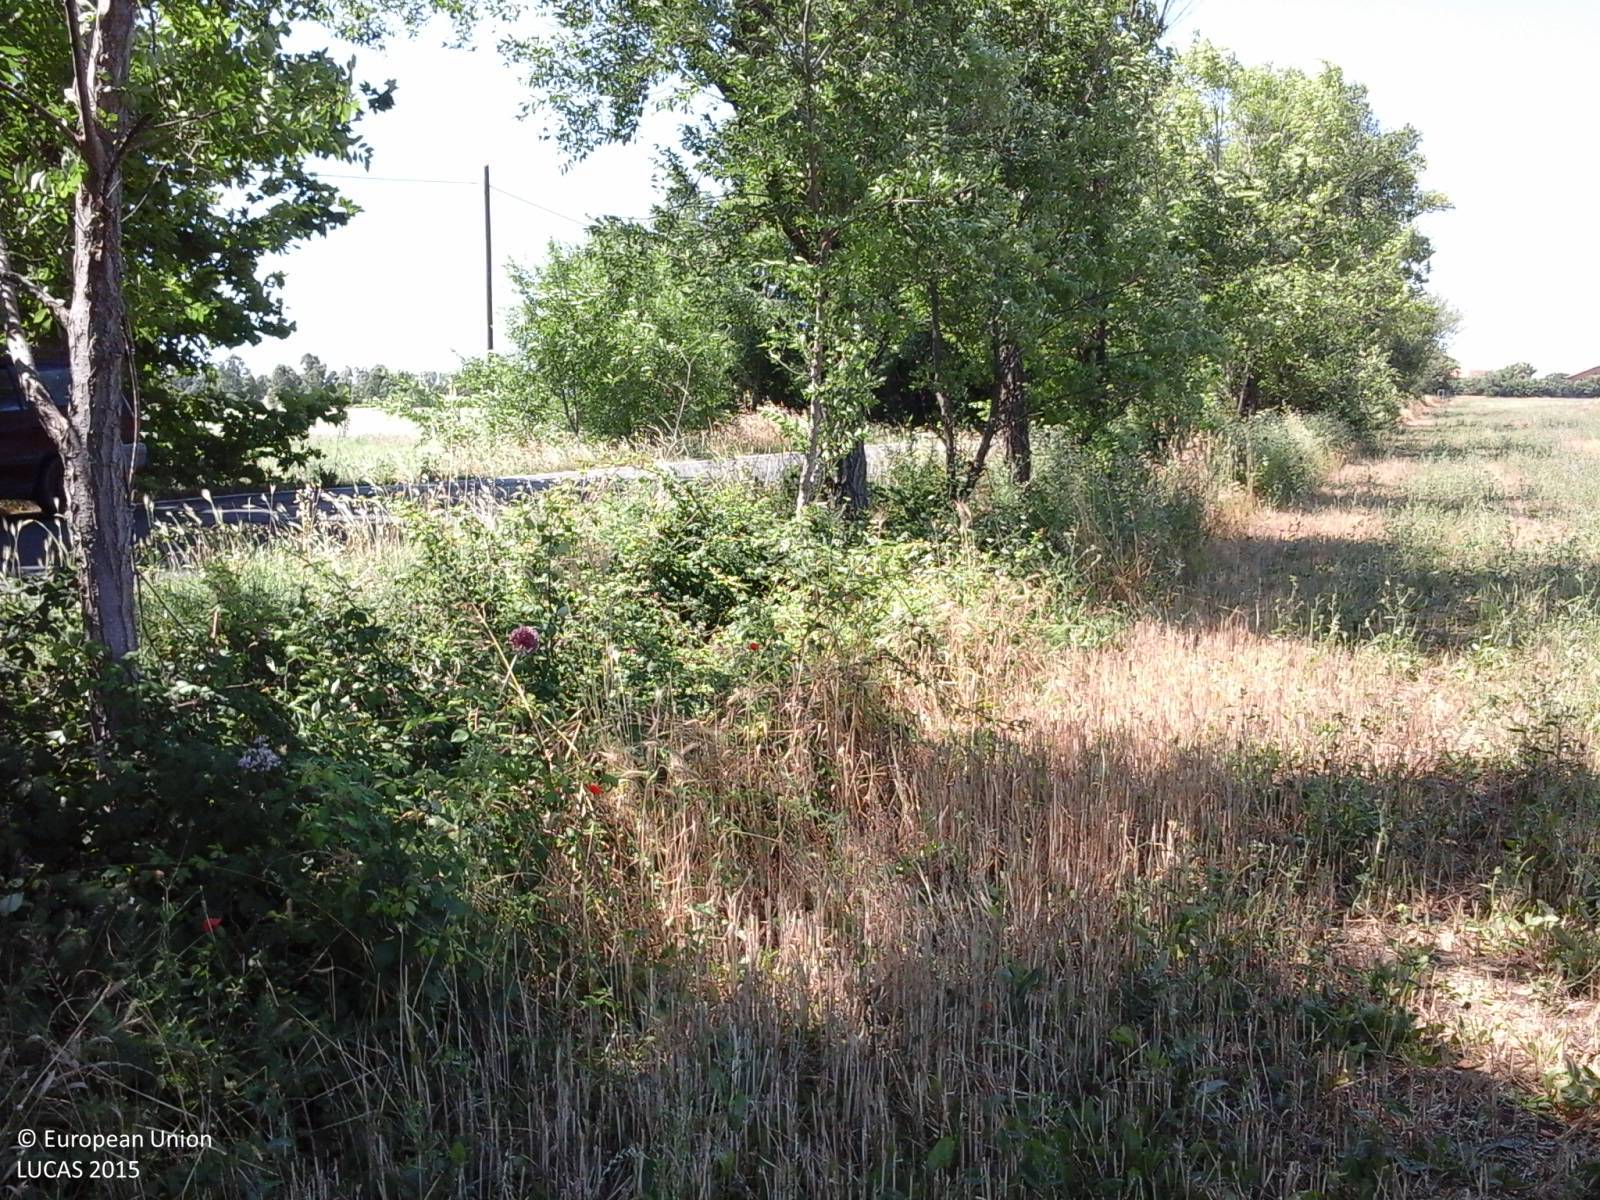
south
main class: Cropland
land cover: Durum wheat
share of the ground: > 75 %
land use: Agriculture (excluding fallow land and kitchen gardens)
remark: Harvested field
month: June
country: IT
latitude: 41.8701
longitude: 12.2445
